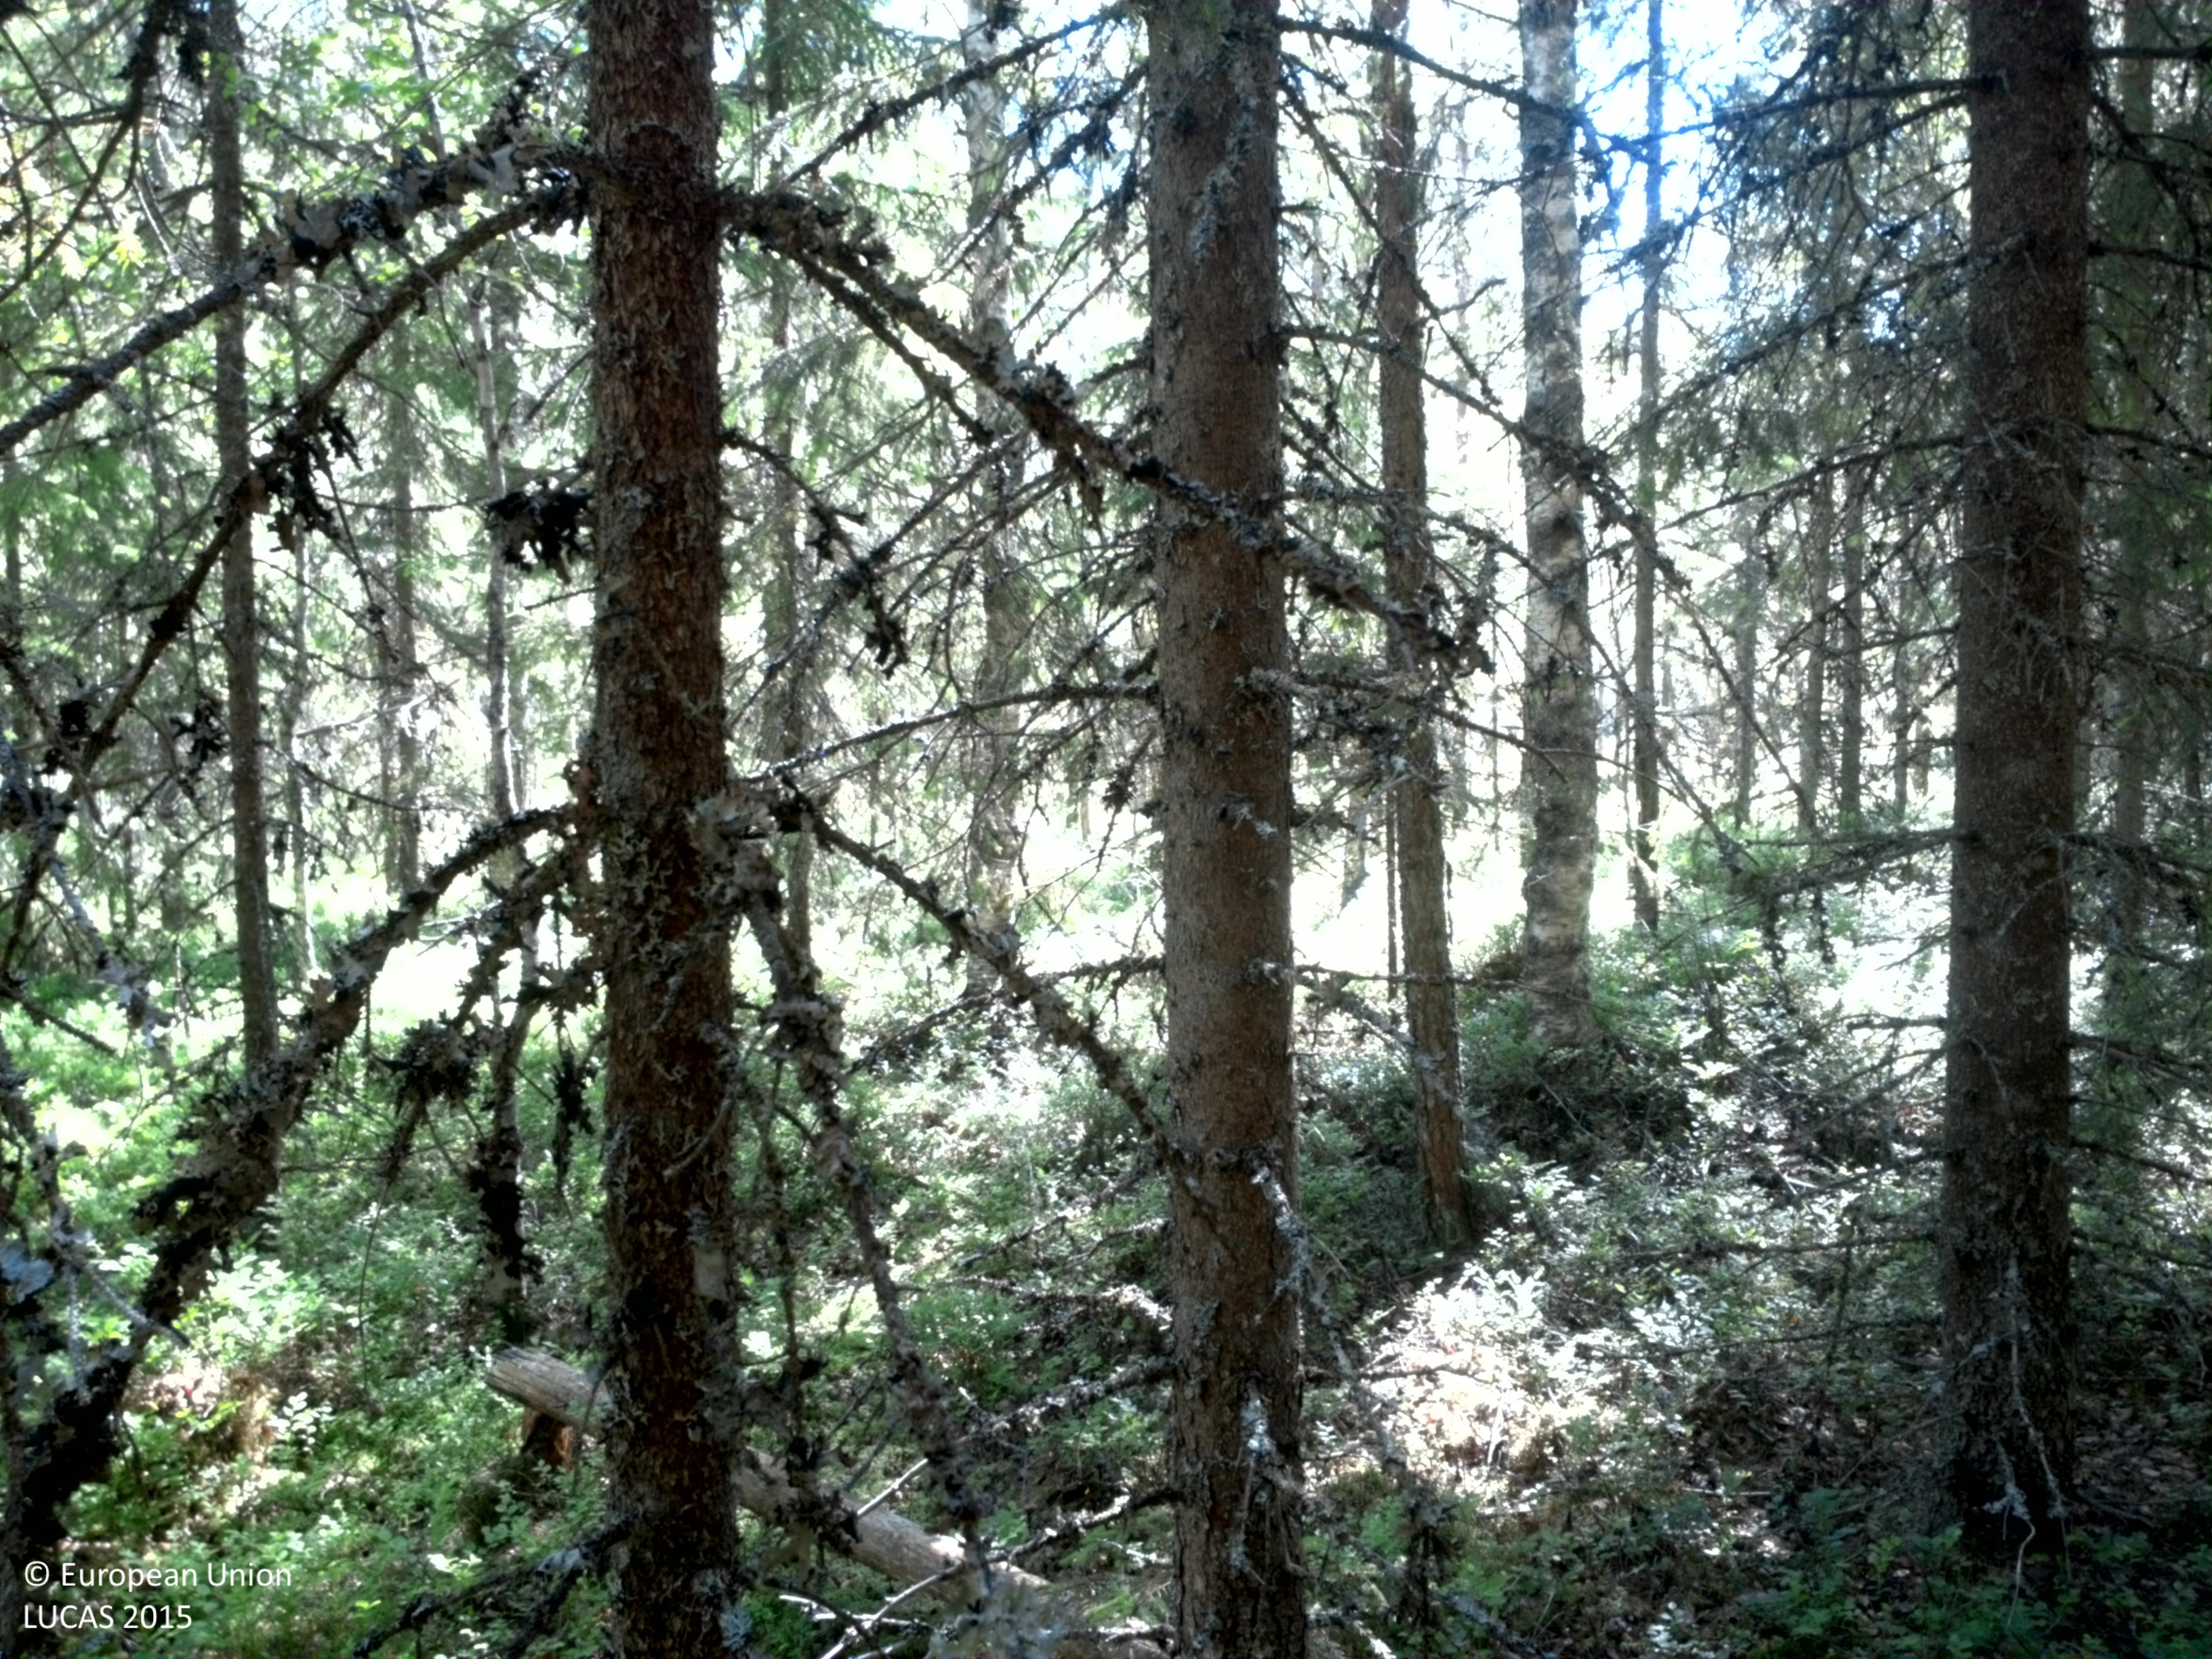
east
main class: Woodland
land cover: Spruce dominated mixed woodland
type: boreal forest
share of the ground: 50 - 75 %
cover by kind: coniferous forest trees 45 %, shrubs 25 %, broadleaved forest trees 15 %, lichens and mosses 15 %
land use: Forestry
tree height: > 5 m
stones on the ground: < 10 %
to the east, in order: Spruce dominated mixed woodland; Pine dominated coniferous woodland; Ditches and canals; Grass margins; Paved roads, cycling and walking lanes; Grass margins; Broadleaved woodland; Rock outcrops; Spruce dominated coniferous woodland; Spruce dominated mixed woodland
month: July
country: SE
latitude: 59.7712
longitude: 11.9356
